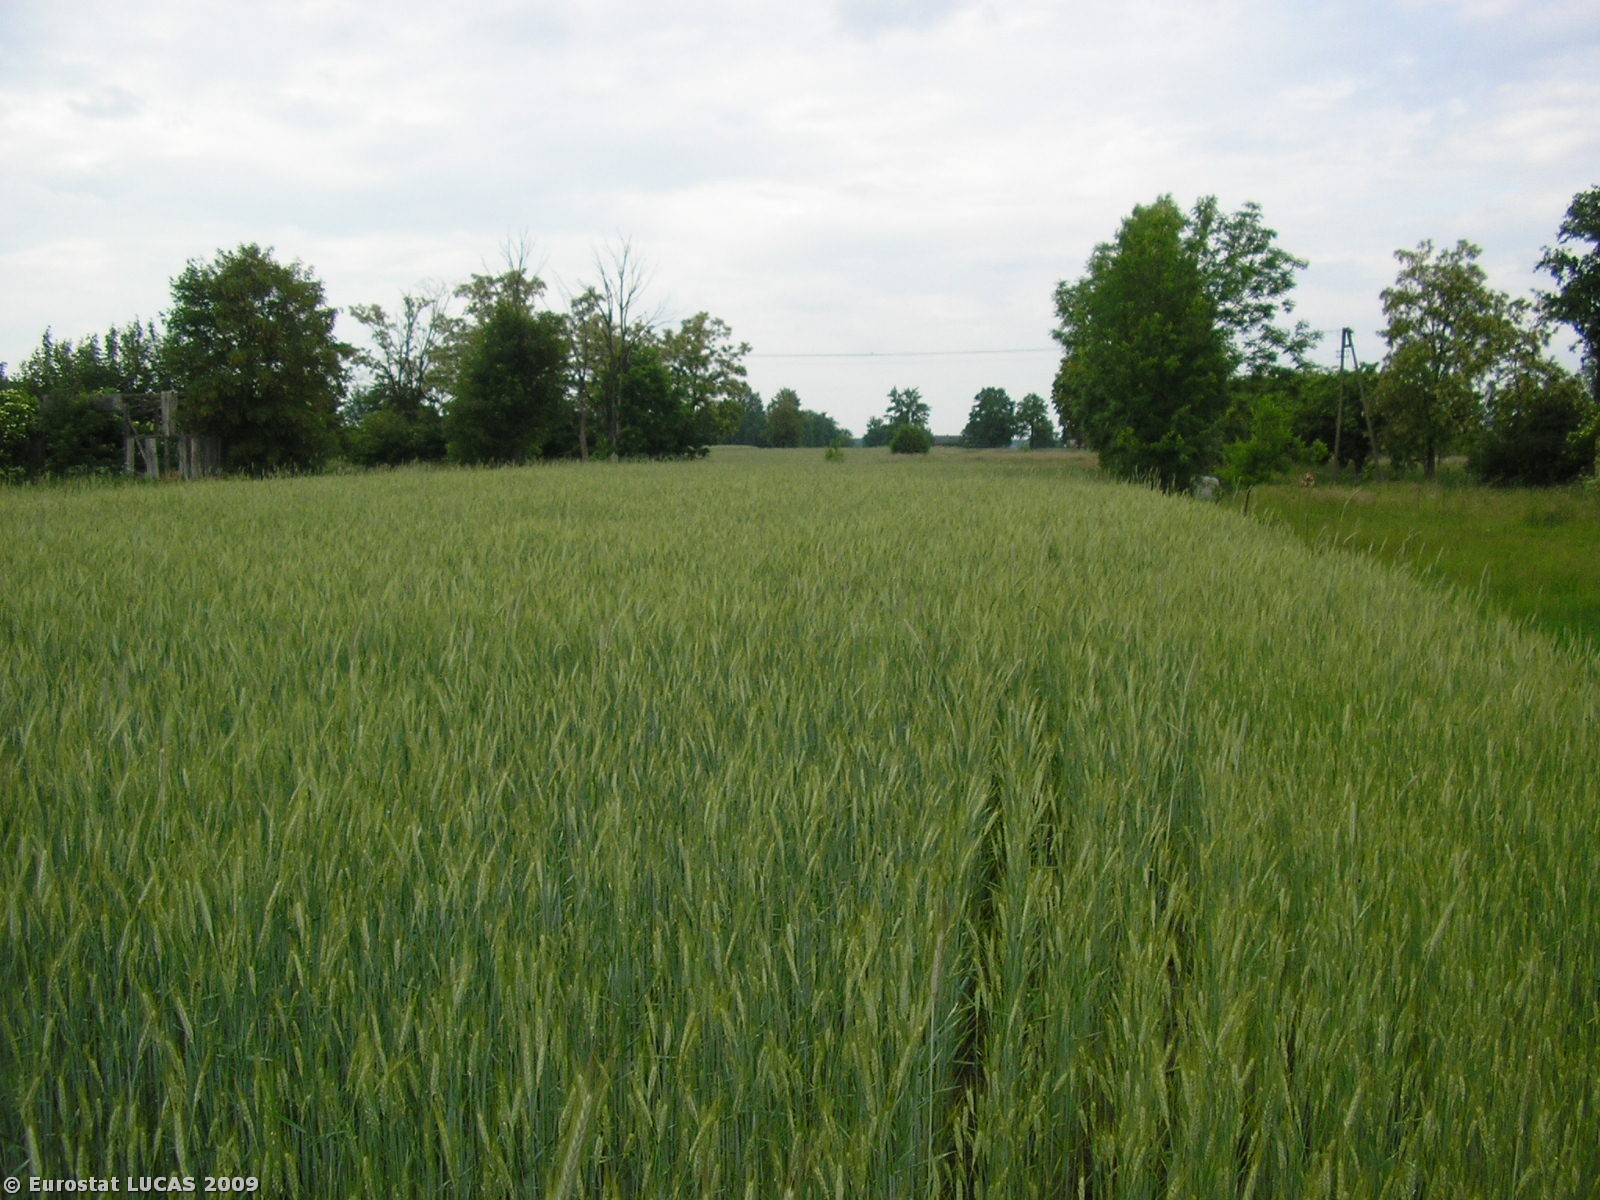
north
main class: Cropland
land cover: Triticale
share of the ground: 50 - 75 %
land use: Agriculture (excluding fallow land and kitchen gardens)
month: June
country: PL
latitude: 51.2342
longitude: 18.3394
